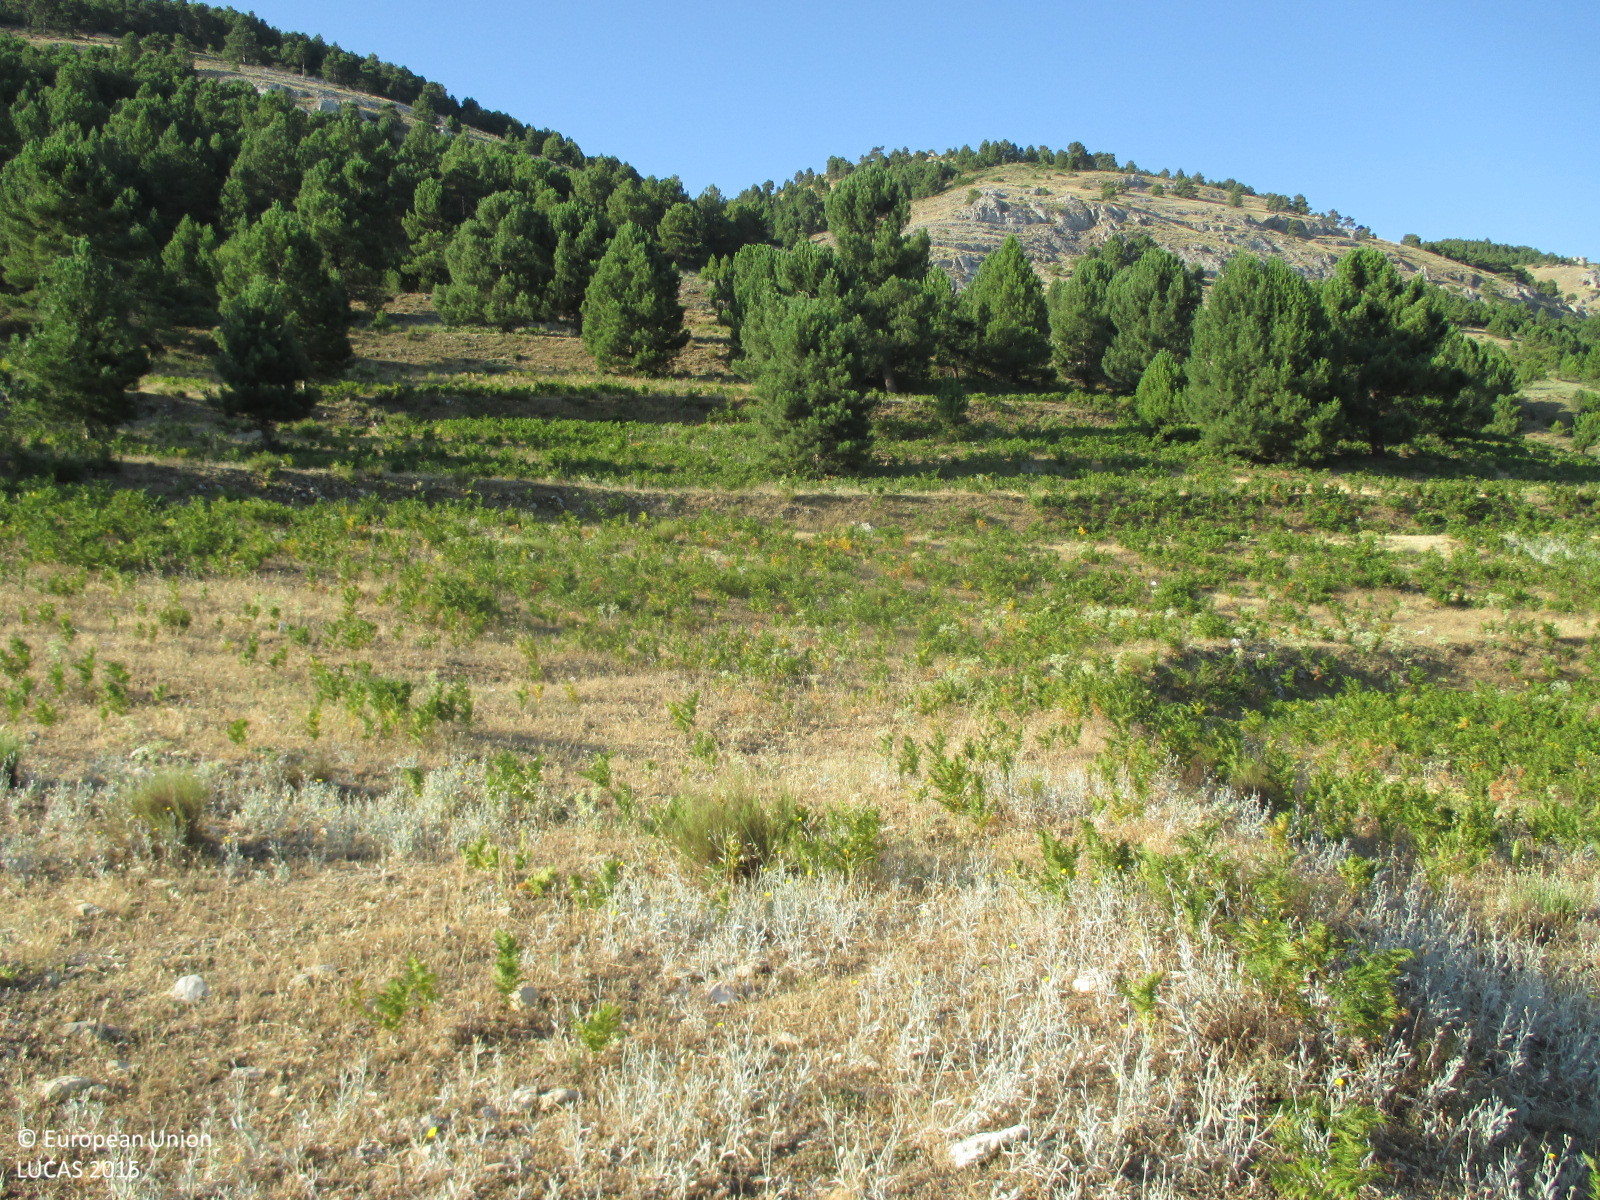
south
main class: Grassland
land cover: Grassland without tree/shrub cover
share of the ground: > 75 %
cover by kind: herbaceous plants 90 %, consolidated bare surface 10 %
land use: Semi-natural and natural areas not in use
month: July
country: ES
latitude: 38.3537
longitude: -2.4584
